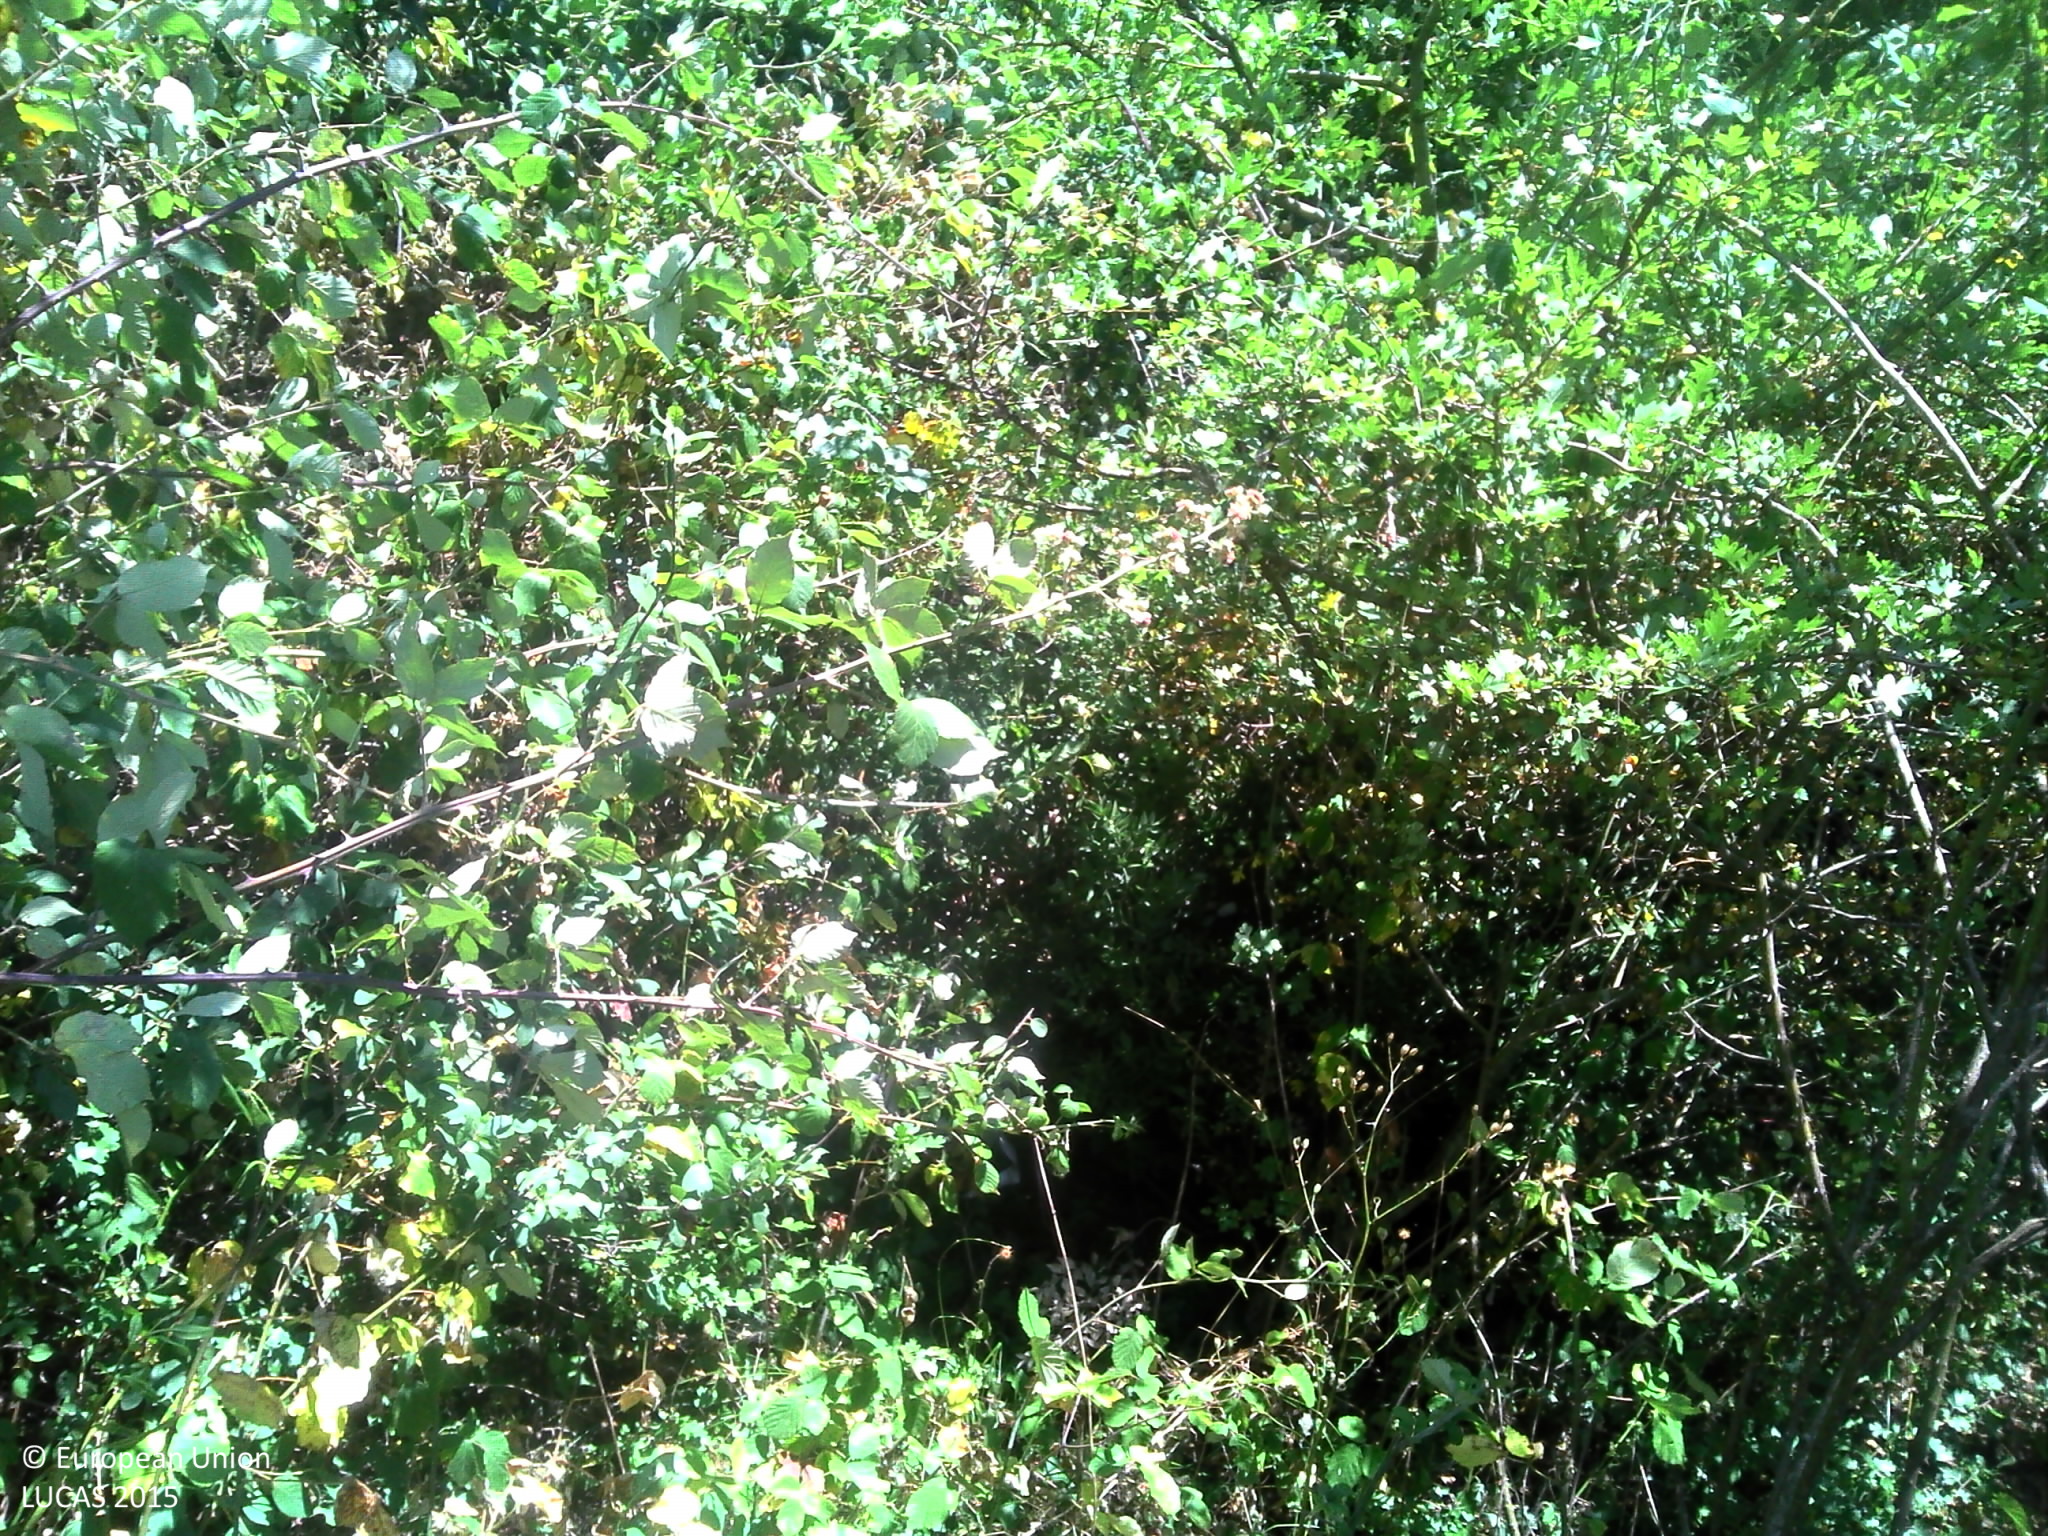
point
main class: Shrubland
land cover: Shrubland without tree cover
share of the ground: > 75 %
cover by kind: shrubs 70 %, herbaceous plants 30 %
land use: Semi-natural and natural areas not in use
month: July
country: FR
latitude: 45.6058
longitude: 5.0678
